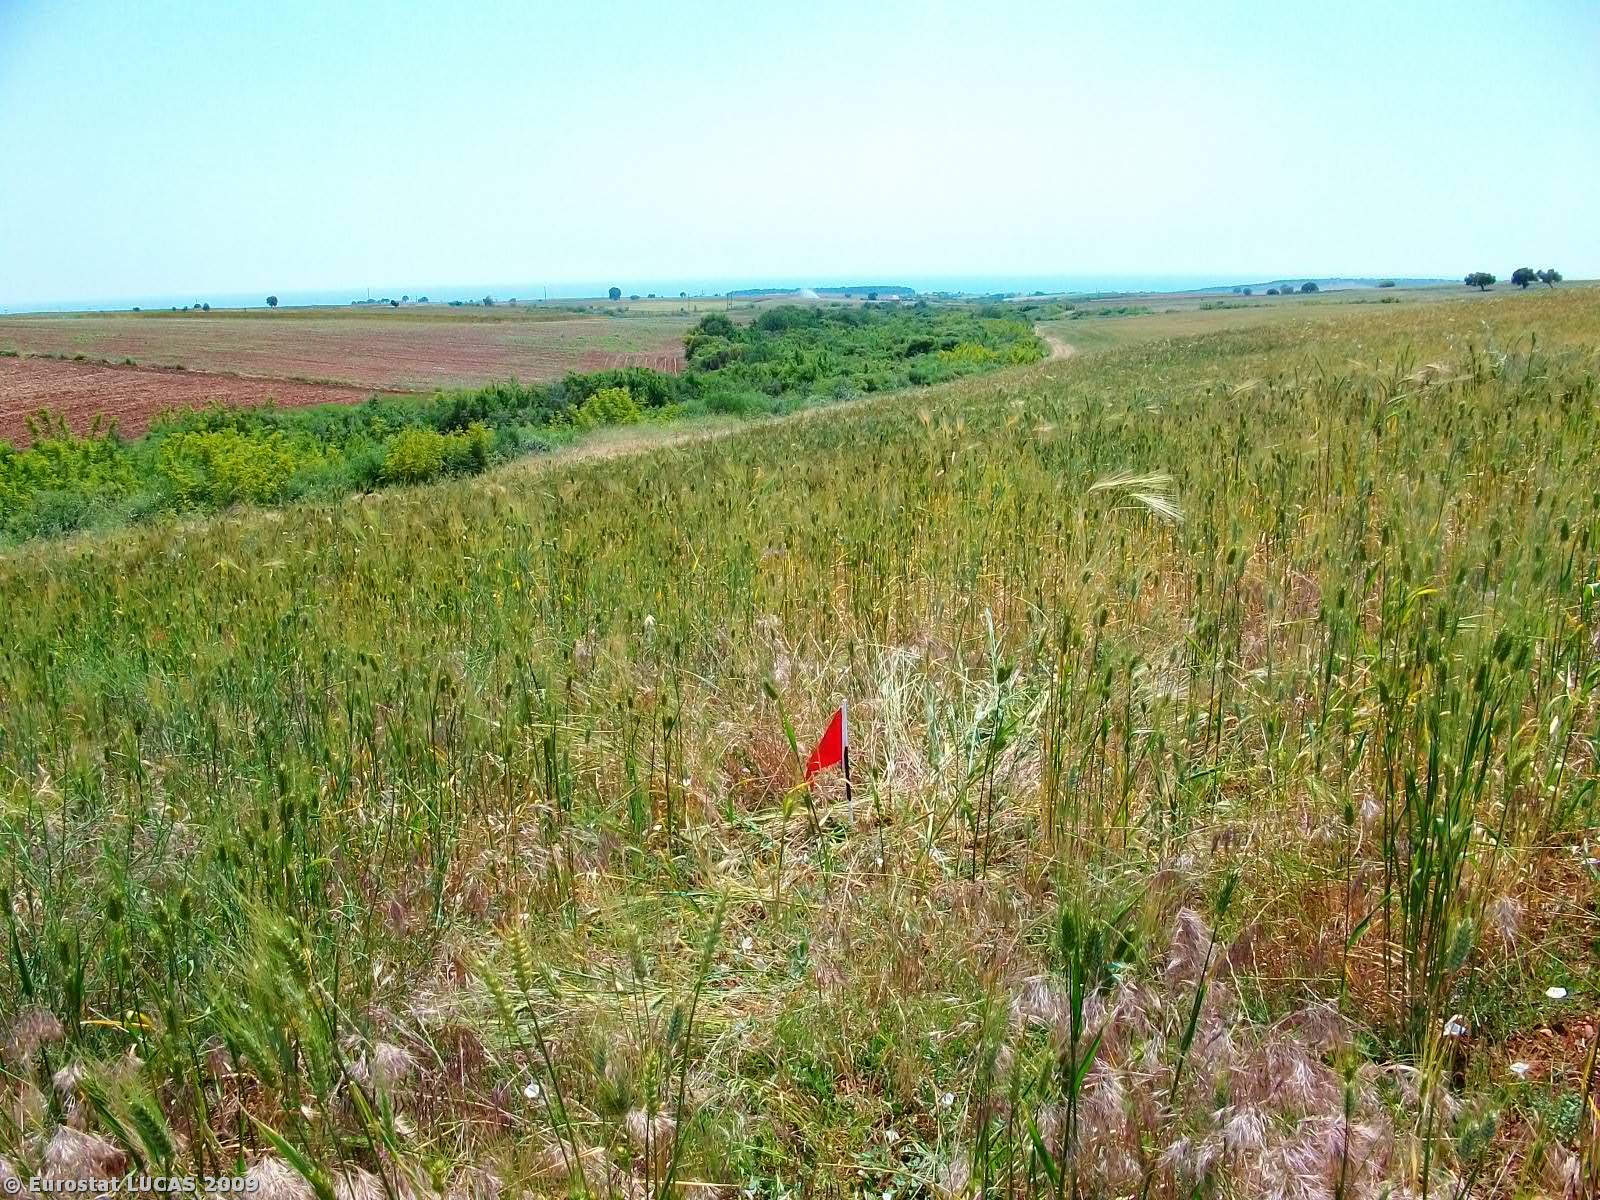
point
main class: Cropland
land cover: Durum wheat
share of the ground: > 75 %
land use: Agriculture (excluding fallow land and kitchen gardens)
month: May
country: GR
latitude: 40.9276
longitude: 25.4514
